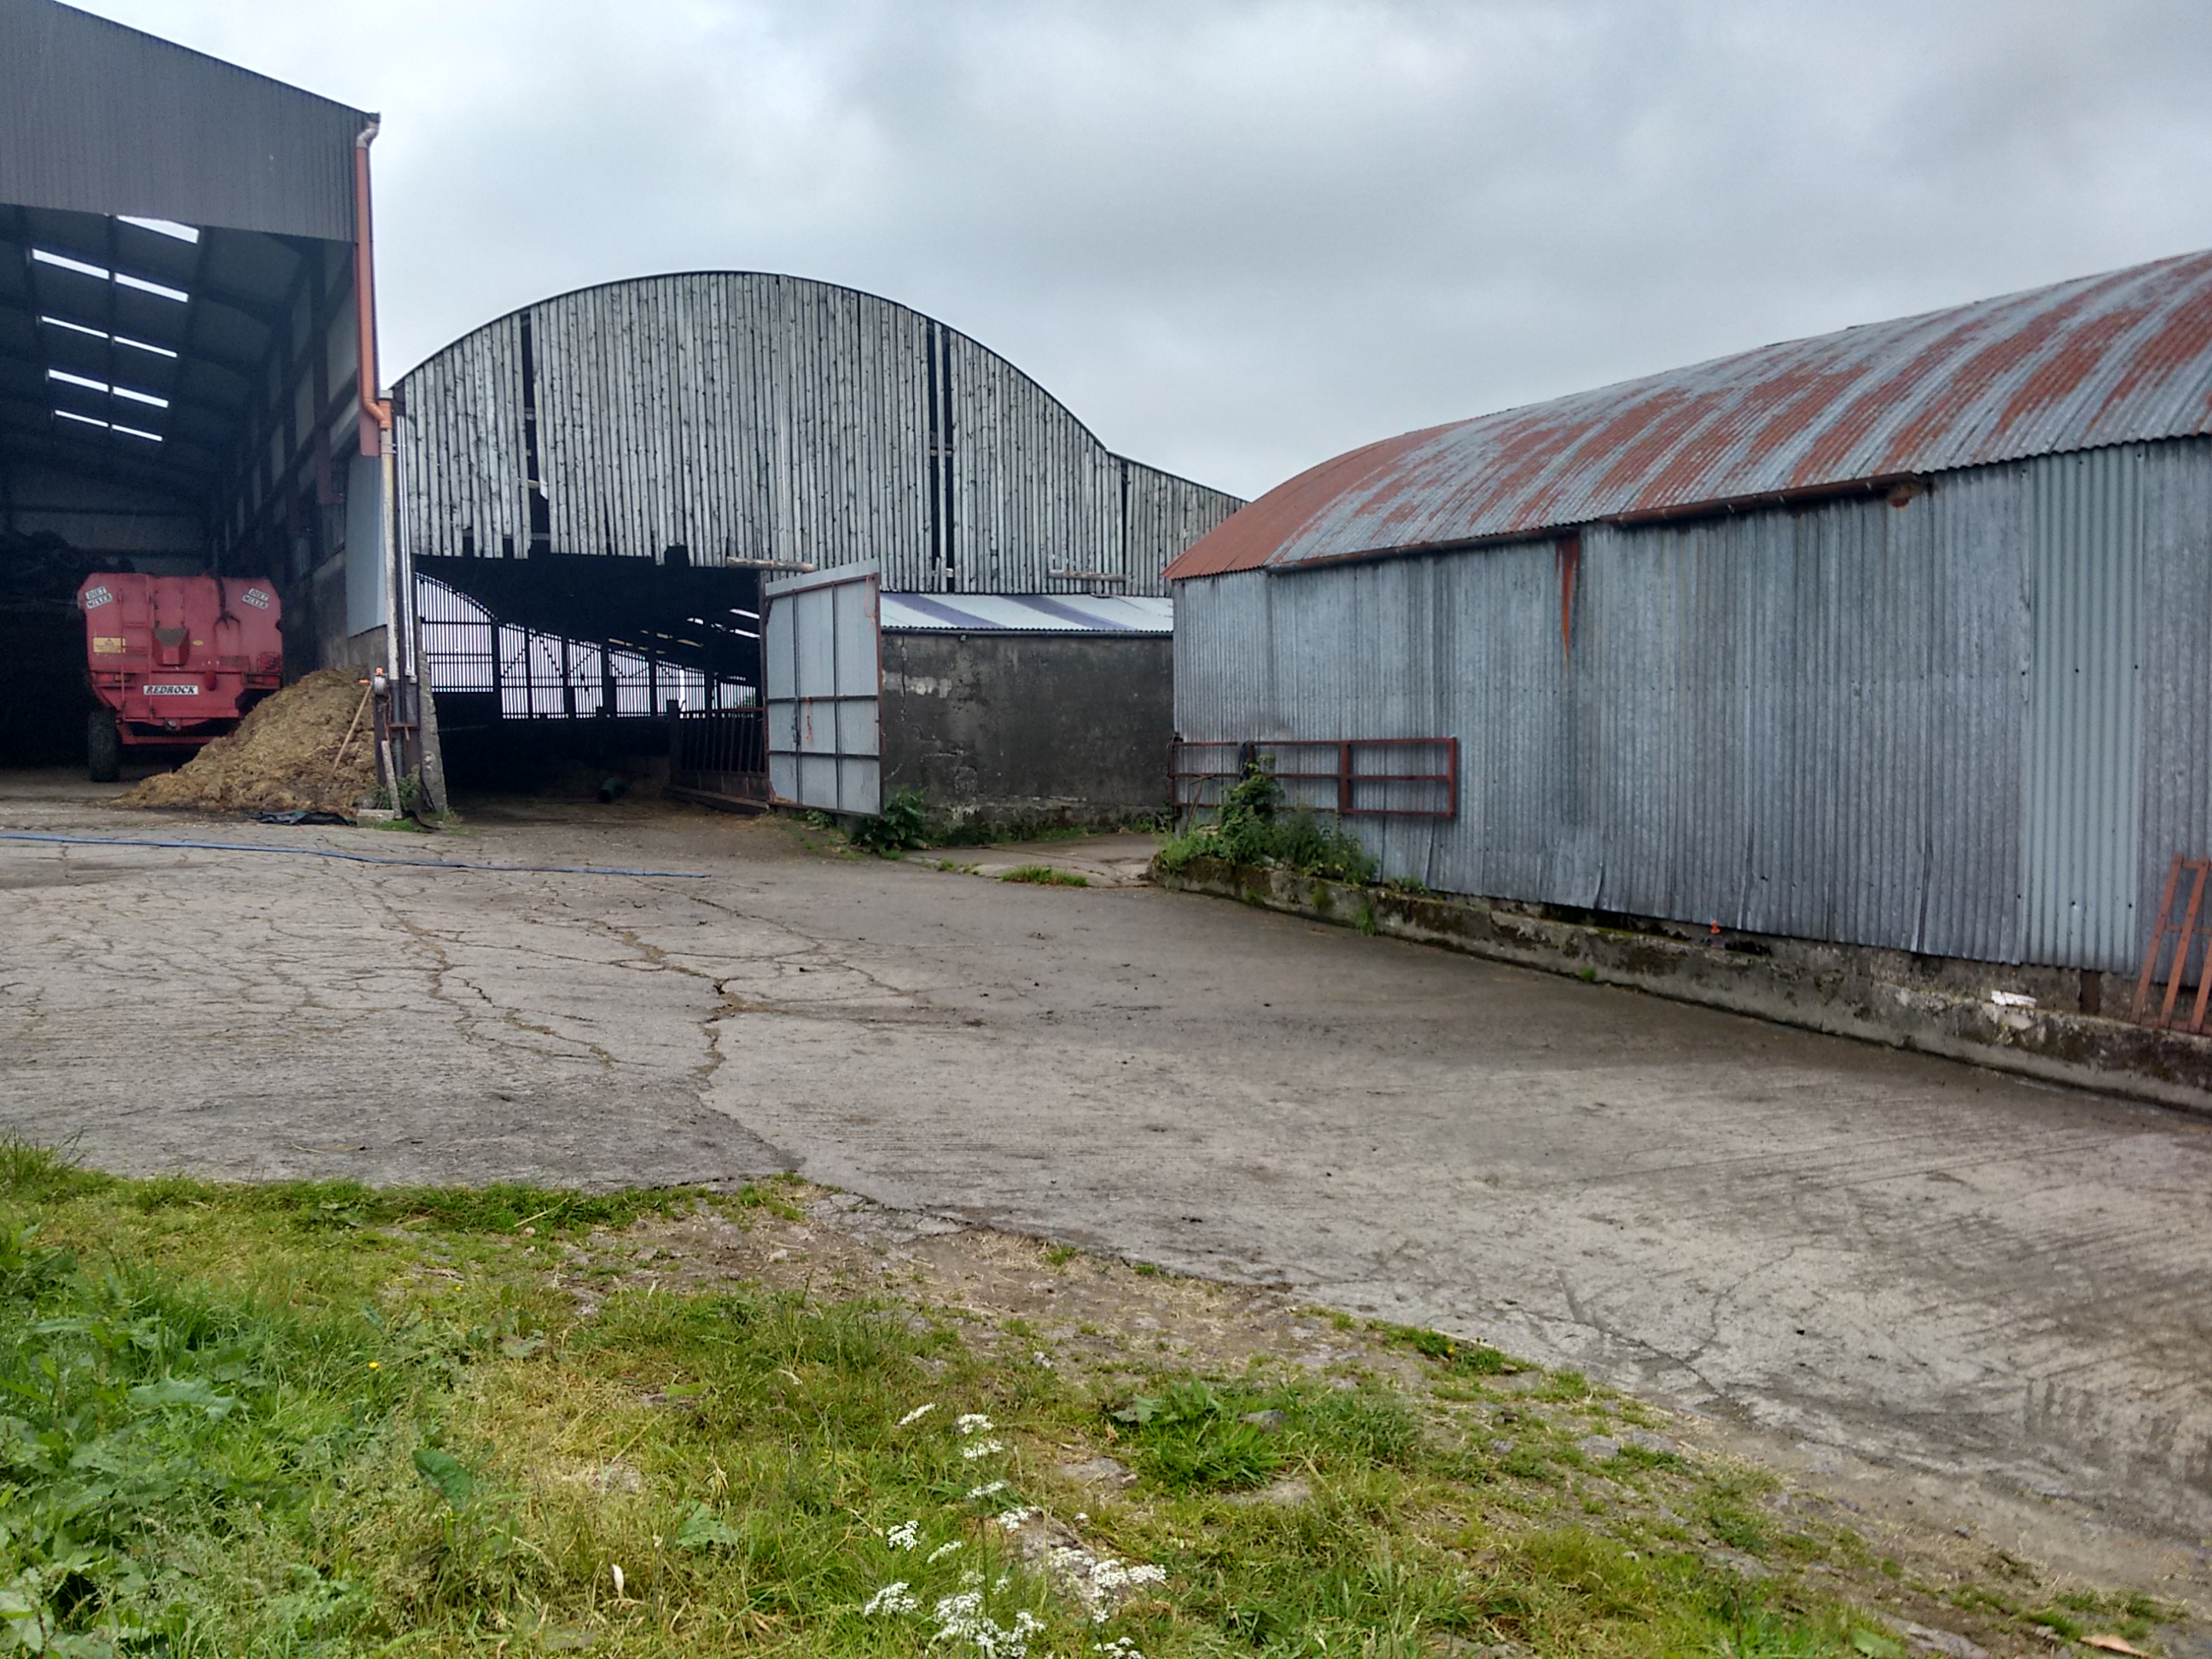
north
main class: Grassland
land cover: Grassland without tree/shrub cover
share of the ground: > 75 %
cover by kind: herbaceous plants 100 %
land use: Agriculture (excluding fallow land and kitchen gardens)
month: June
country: GB
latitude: 54.6783
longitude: -7.4781
